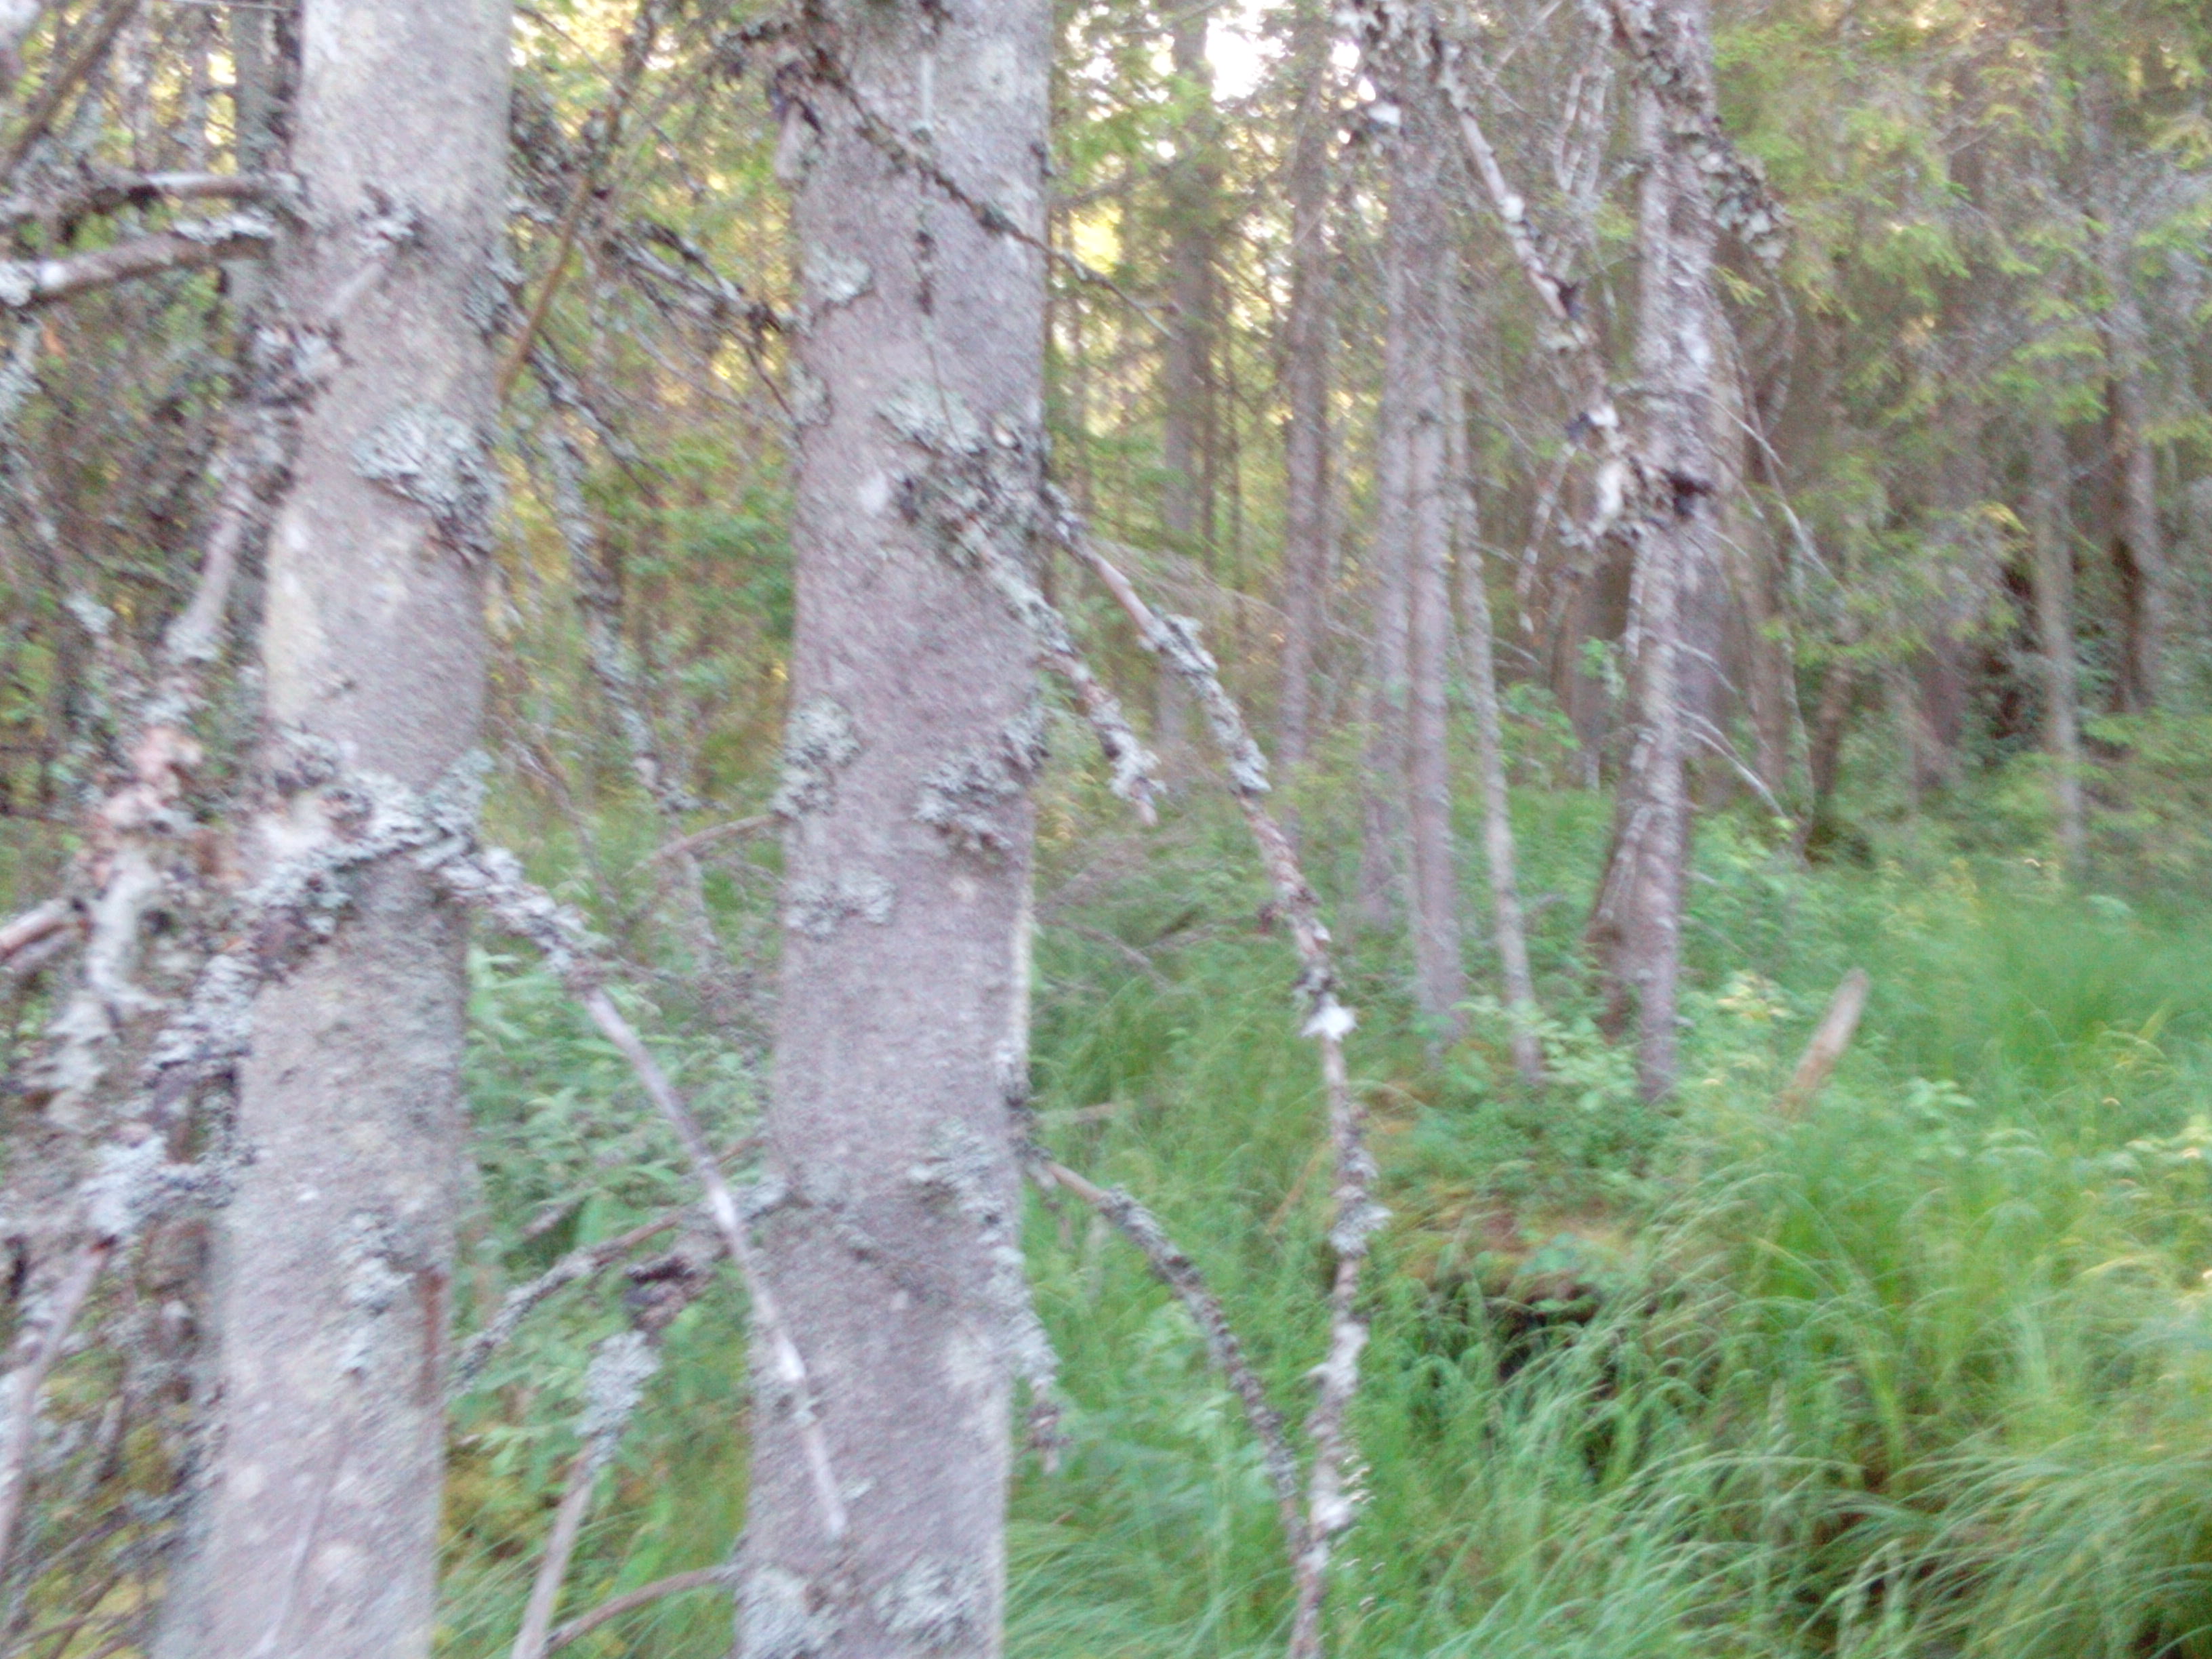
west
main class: Woodland
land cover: Spruce dominated mixed woodland
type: hemiboreal forest and nemoral coniferous forest and mixed broadleaved-coniferous forest
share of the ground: > 75 %
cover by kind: broadleaved forest trees 55 %, coniferous forest trees 25 %, herbaceous plants 15 %, lichens and mosses 5 %
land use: Forestry
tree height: > 5 m
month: July
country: LV
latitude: 56.4735
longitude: 21.8494
